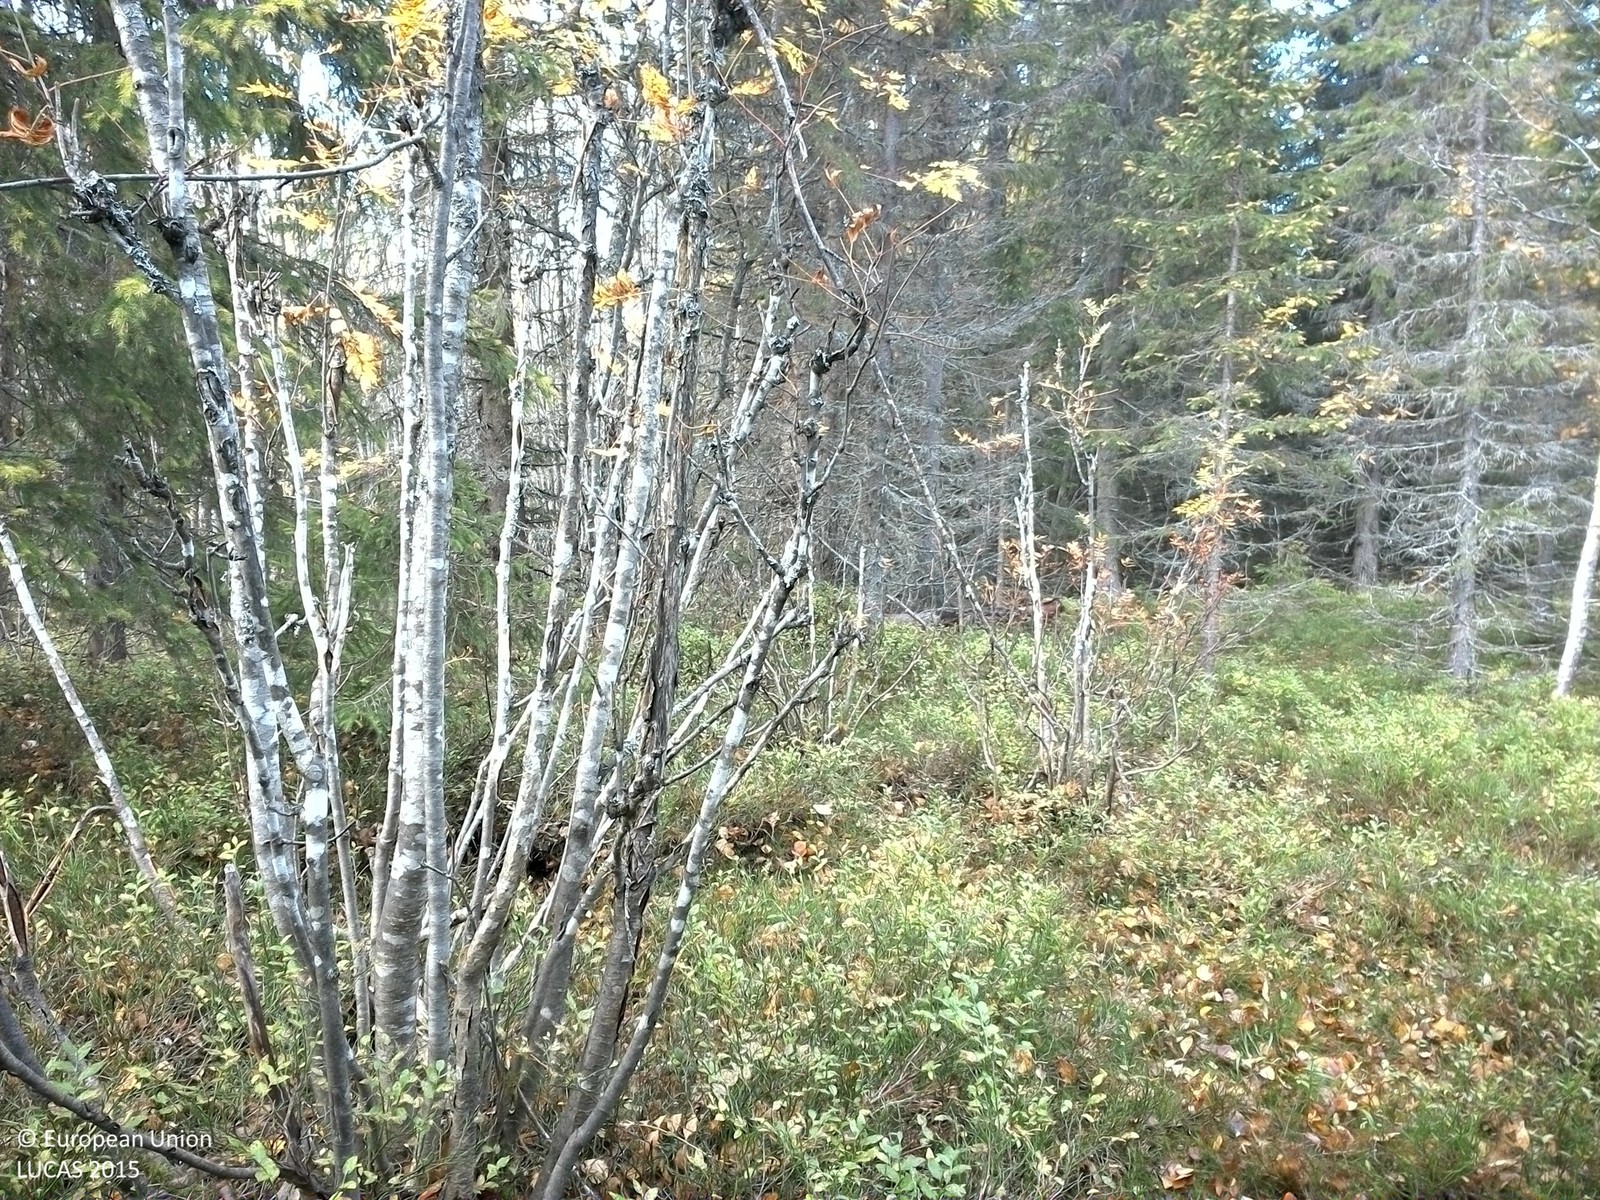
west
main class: Woodland
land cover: Spruce dominated mixed woodland
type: boreal forest
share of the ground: 50 - 75 %
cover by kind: coniferous forest trees 40 %, shrubs 25 %, broadleaved forest trees 15 %, lichens and mosses 15 %, herbaceous plants 5 %
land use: Forestry
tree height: > 5 m
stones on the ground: 10 - 25 %
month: October
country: SE
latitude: 64.3393
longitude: 15.9926
